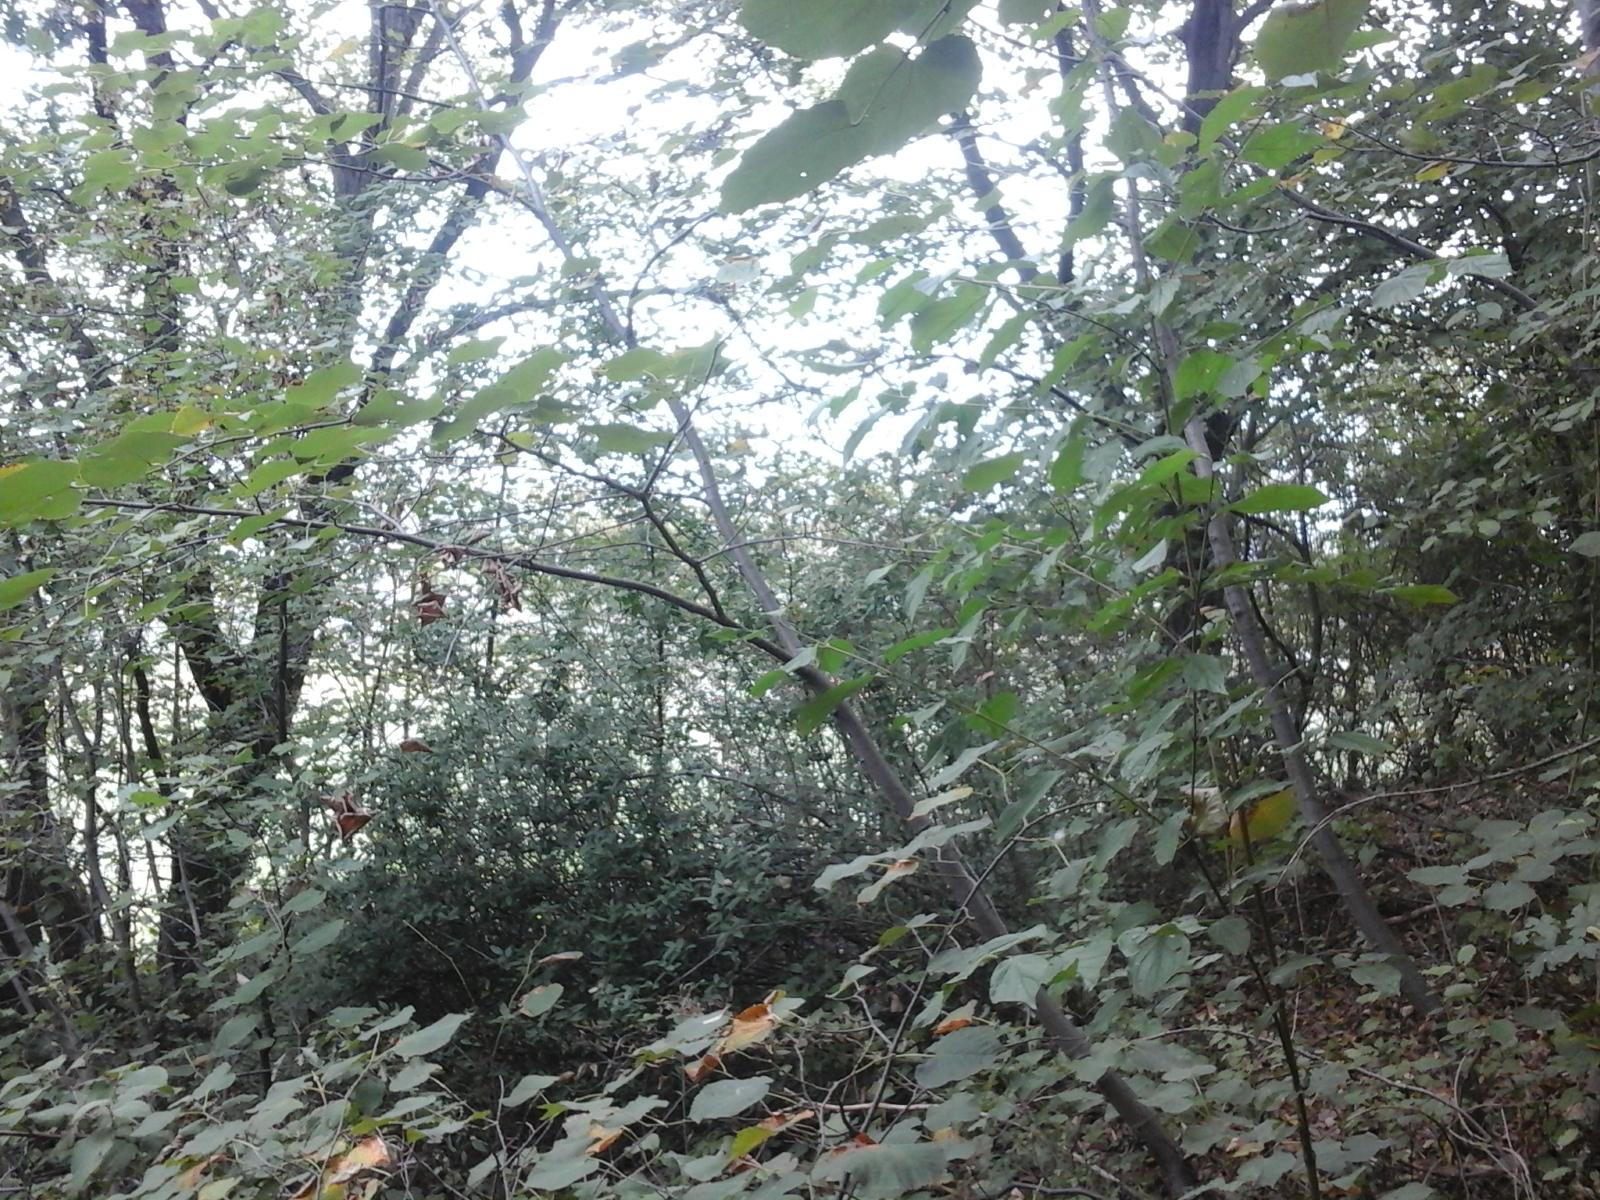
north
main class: Woodland
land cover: Broadleaved woodland
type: beech forest
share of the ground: > 75 %
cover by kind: broadleaved forest trees 100 %
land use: Forestry
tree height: > 5 m
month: August
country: RO
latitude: 46.2758
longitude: 21.6530
